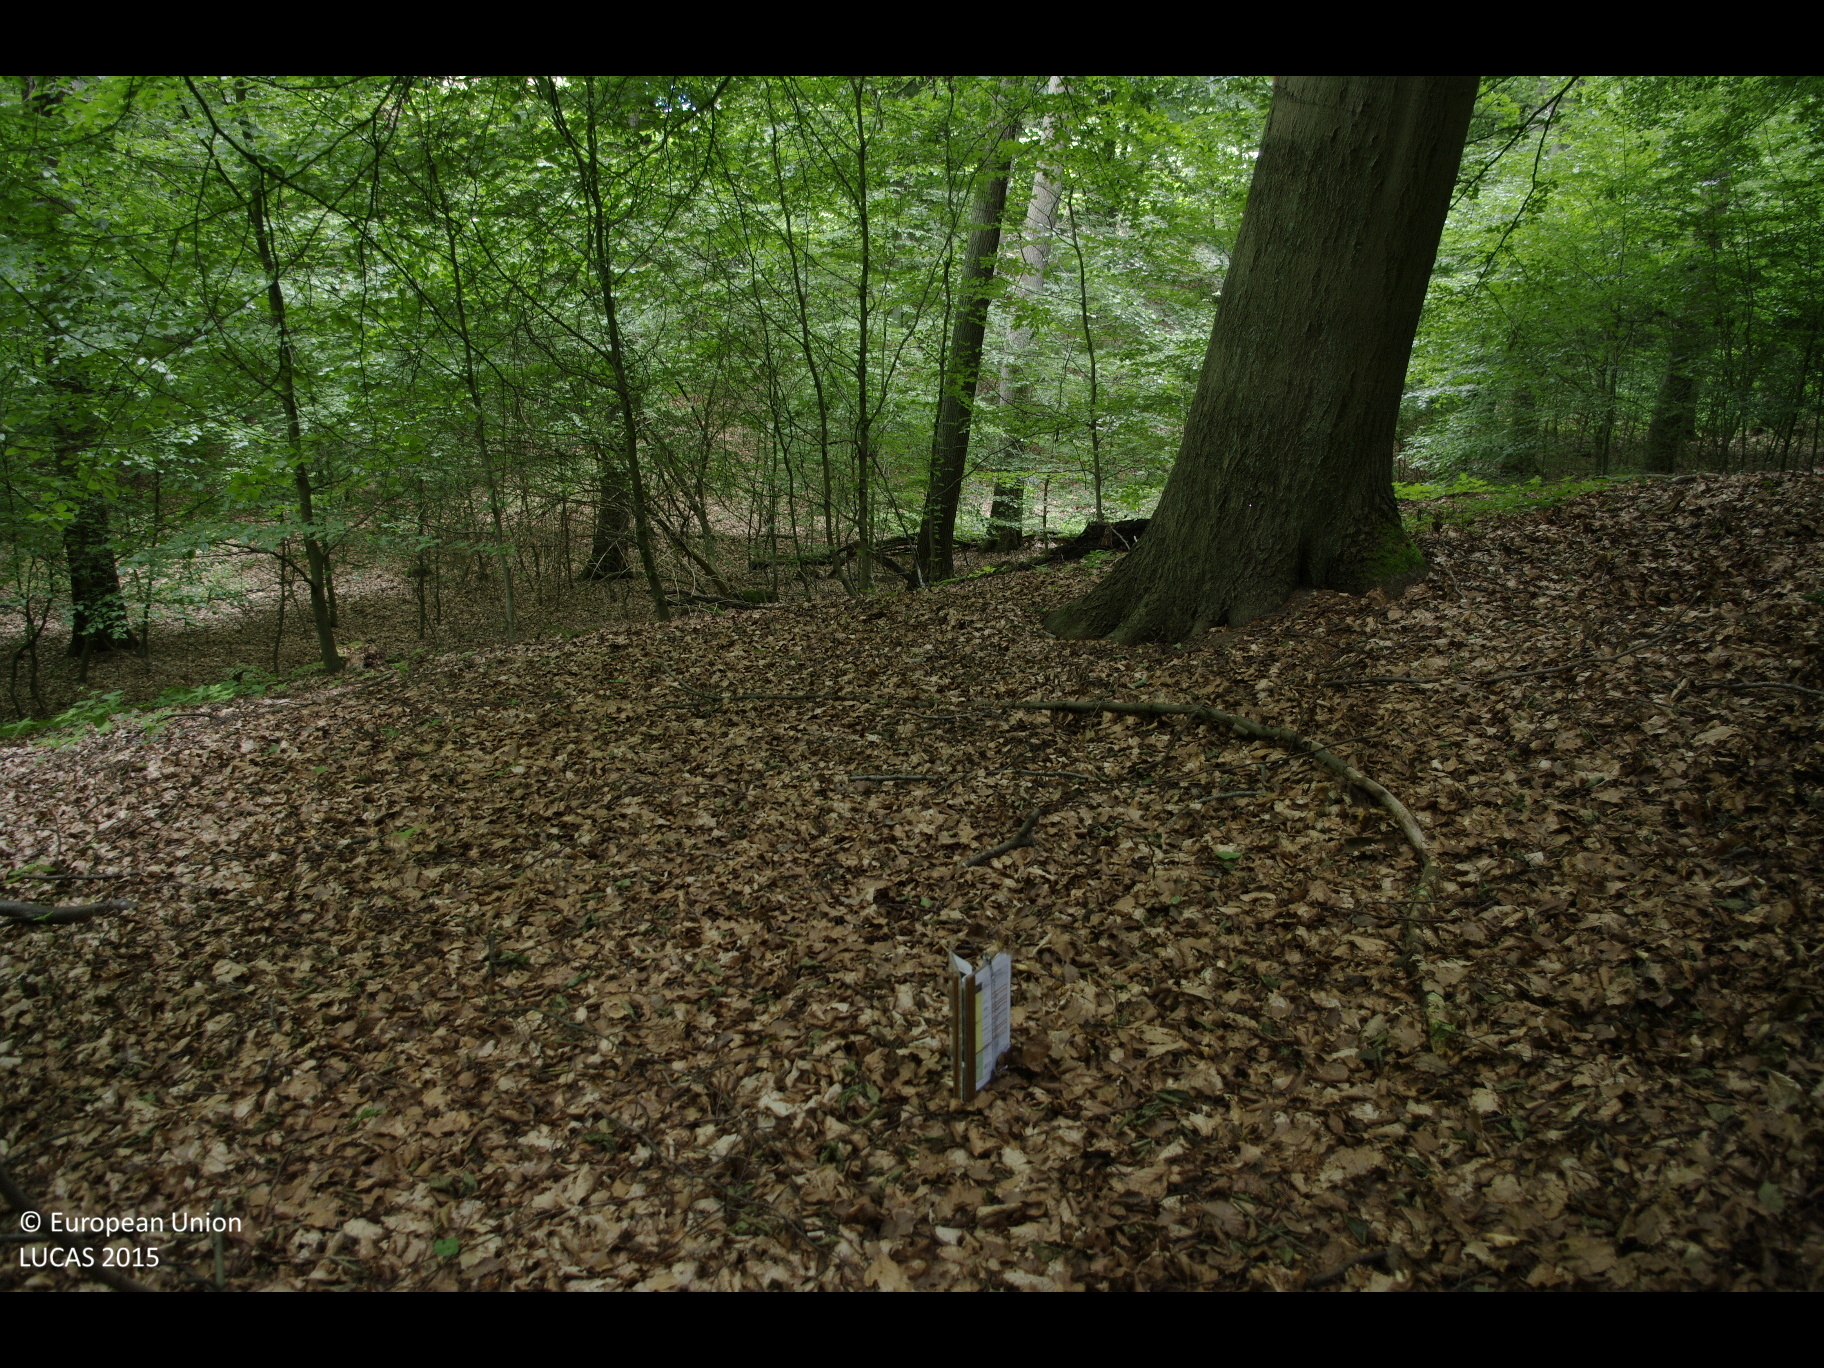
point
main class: Woodland
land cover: Broadleaved woodland
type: mesophytic deciduous forest
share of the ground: > 75 %
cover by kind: broadleaved forest trees 90 %, herbaceous plants 5 %, unconsolidated bare surface 5 %
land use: Forestry
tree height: > 5 m
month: July
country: DE
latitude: 53.4558
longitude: 9.9247
